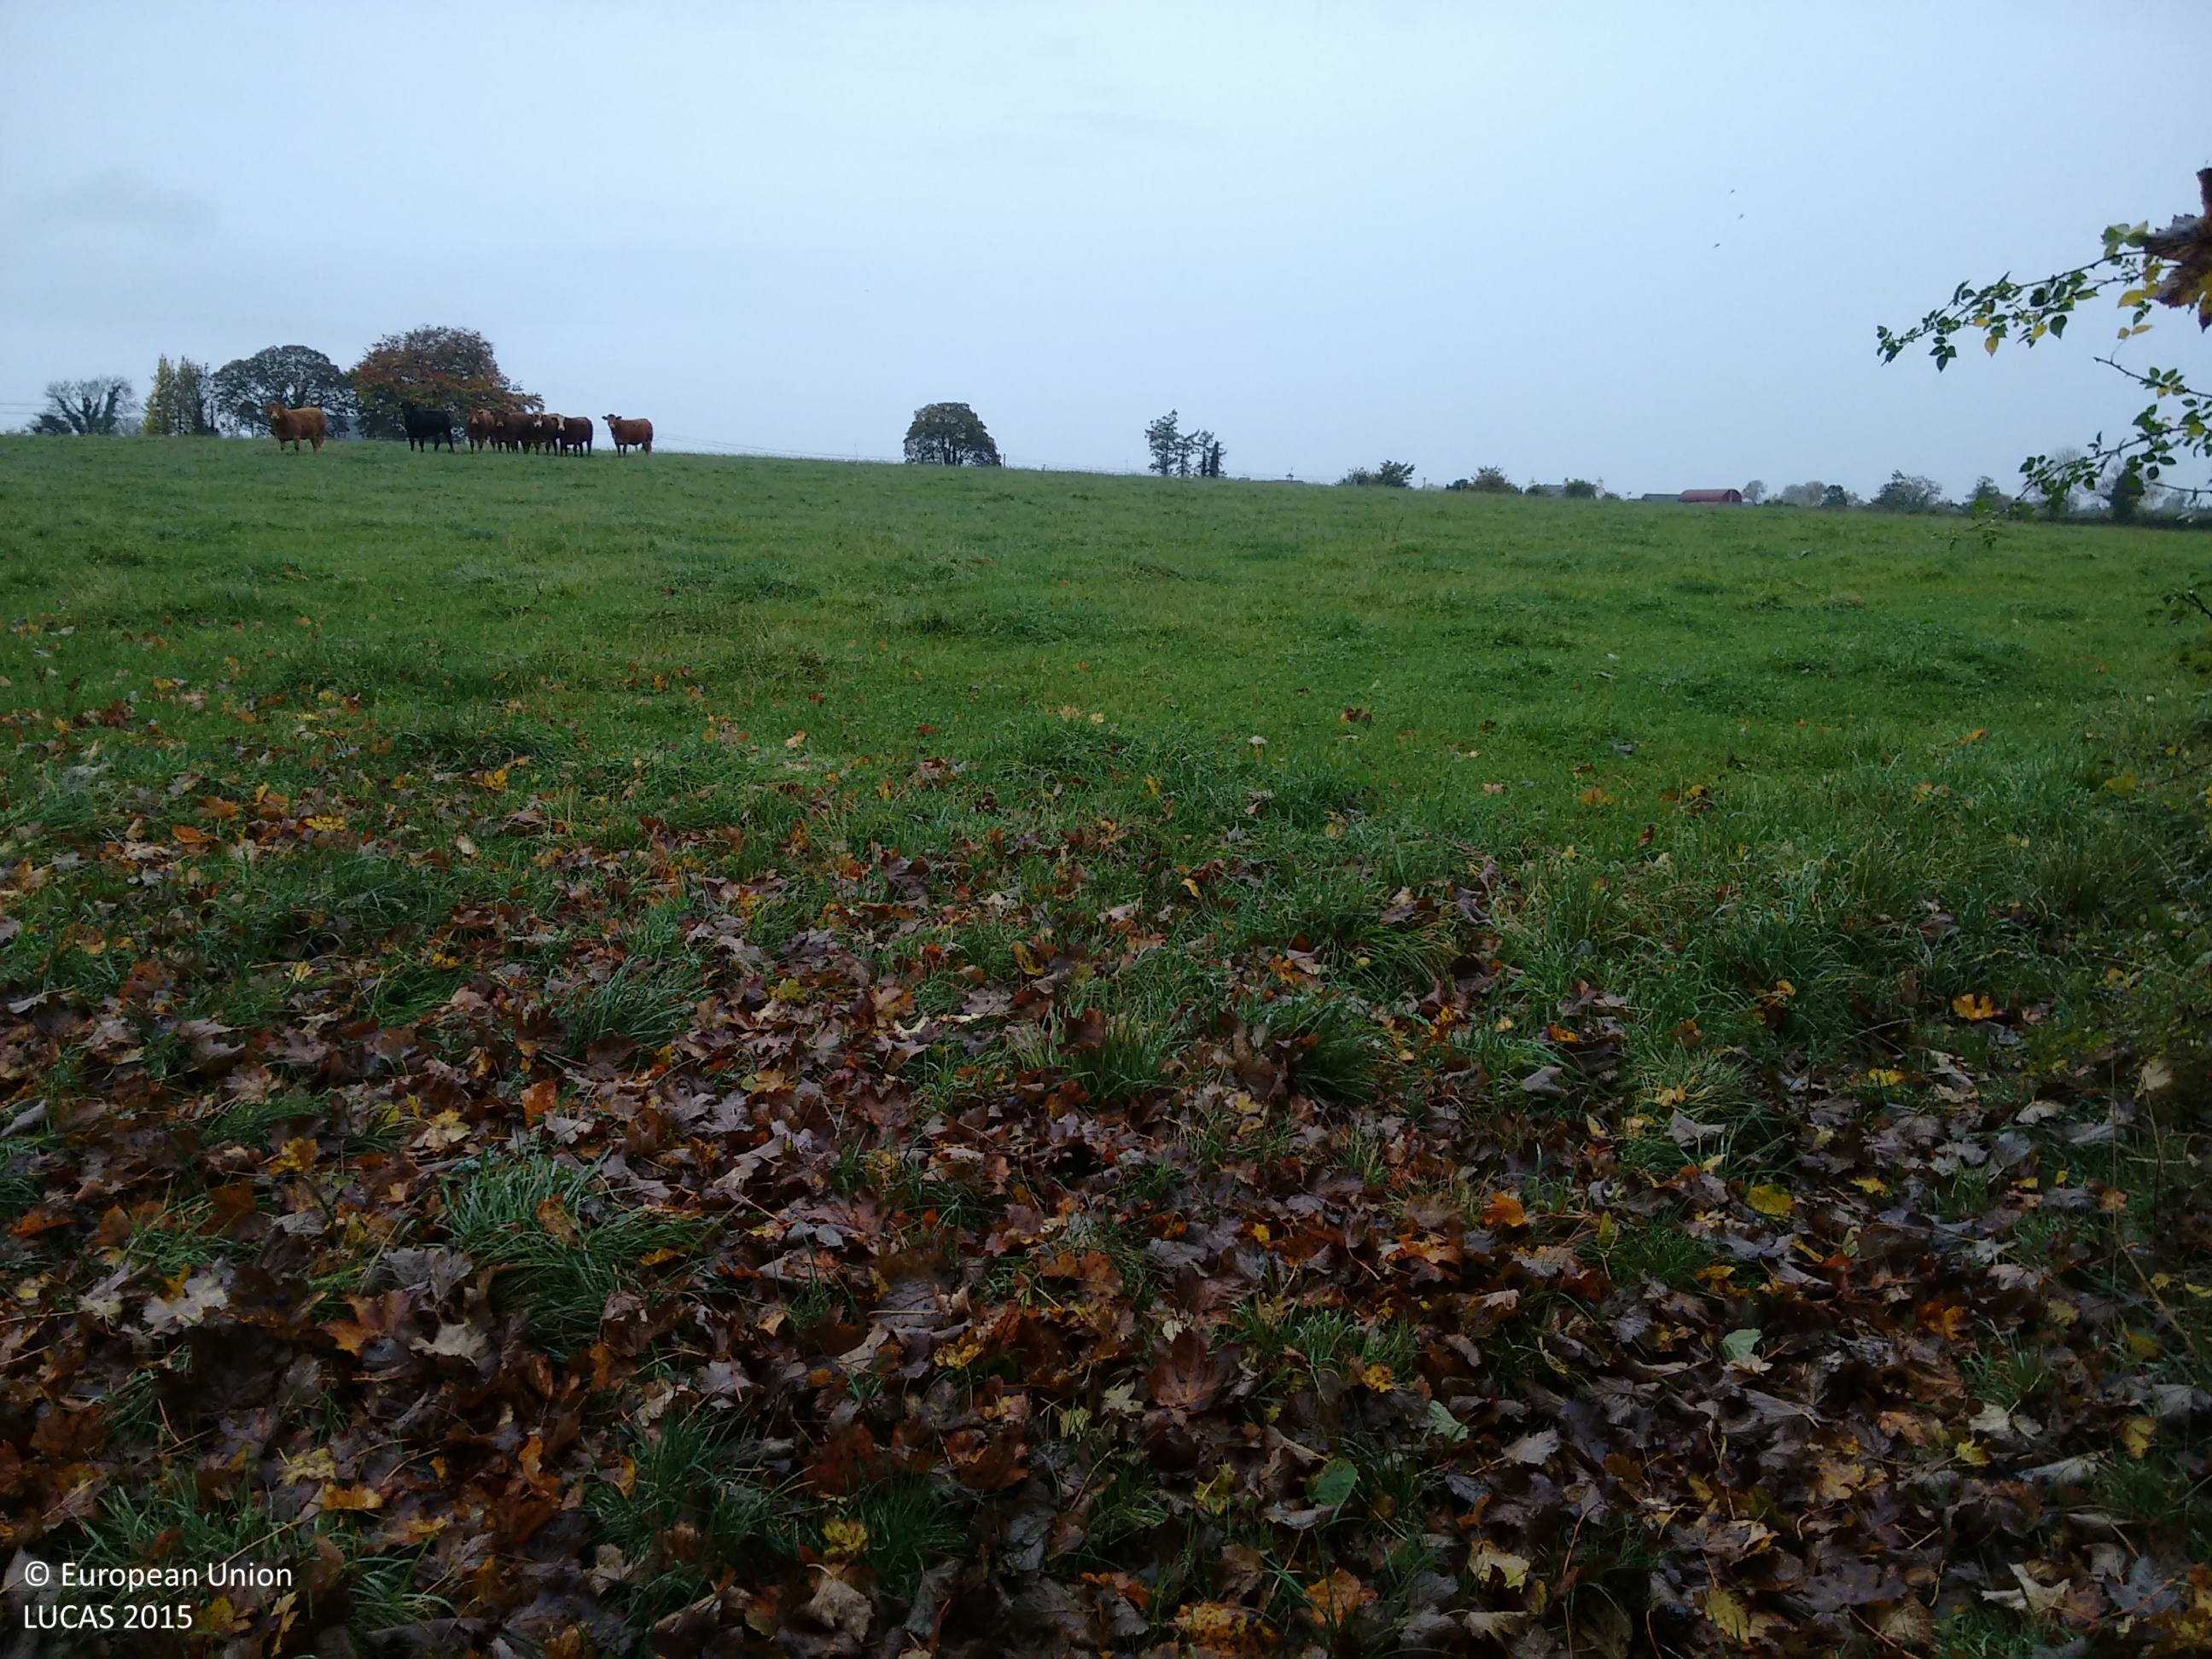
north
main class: Grassland
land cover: Grassland without tree/shrub cover
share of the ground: > 75 %
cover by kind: herbaceous plants 100 %
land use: Agriculture (excluding fallow land and kitchen gardens)
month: October
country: IE
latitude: 52.8862
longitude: -7.5022
